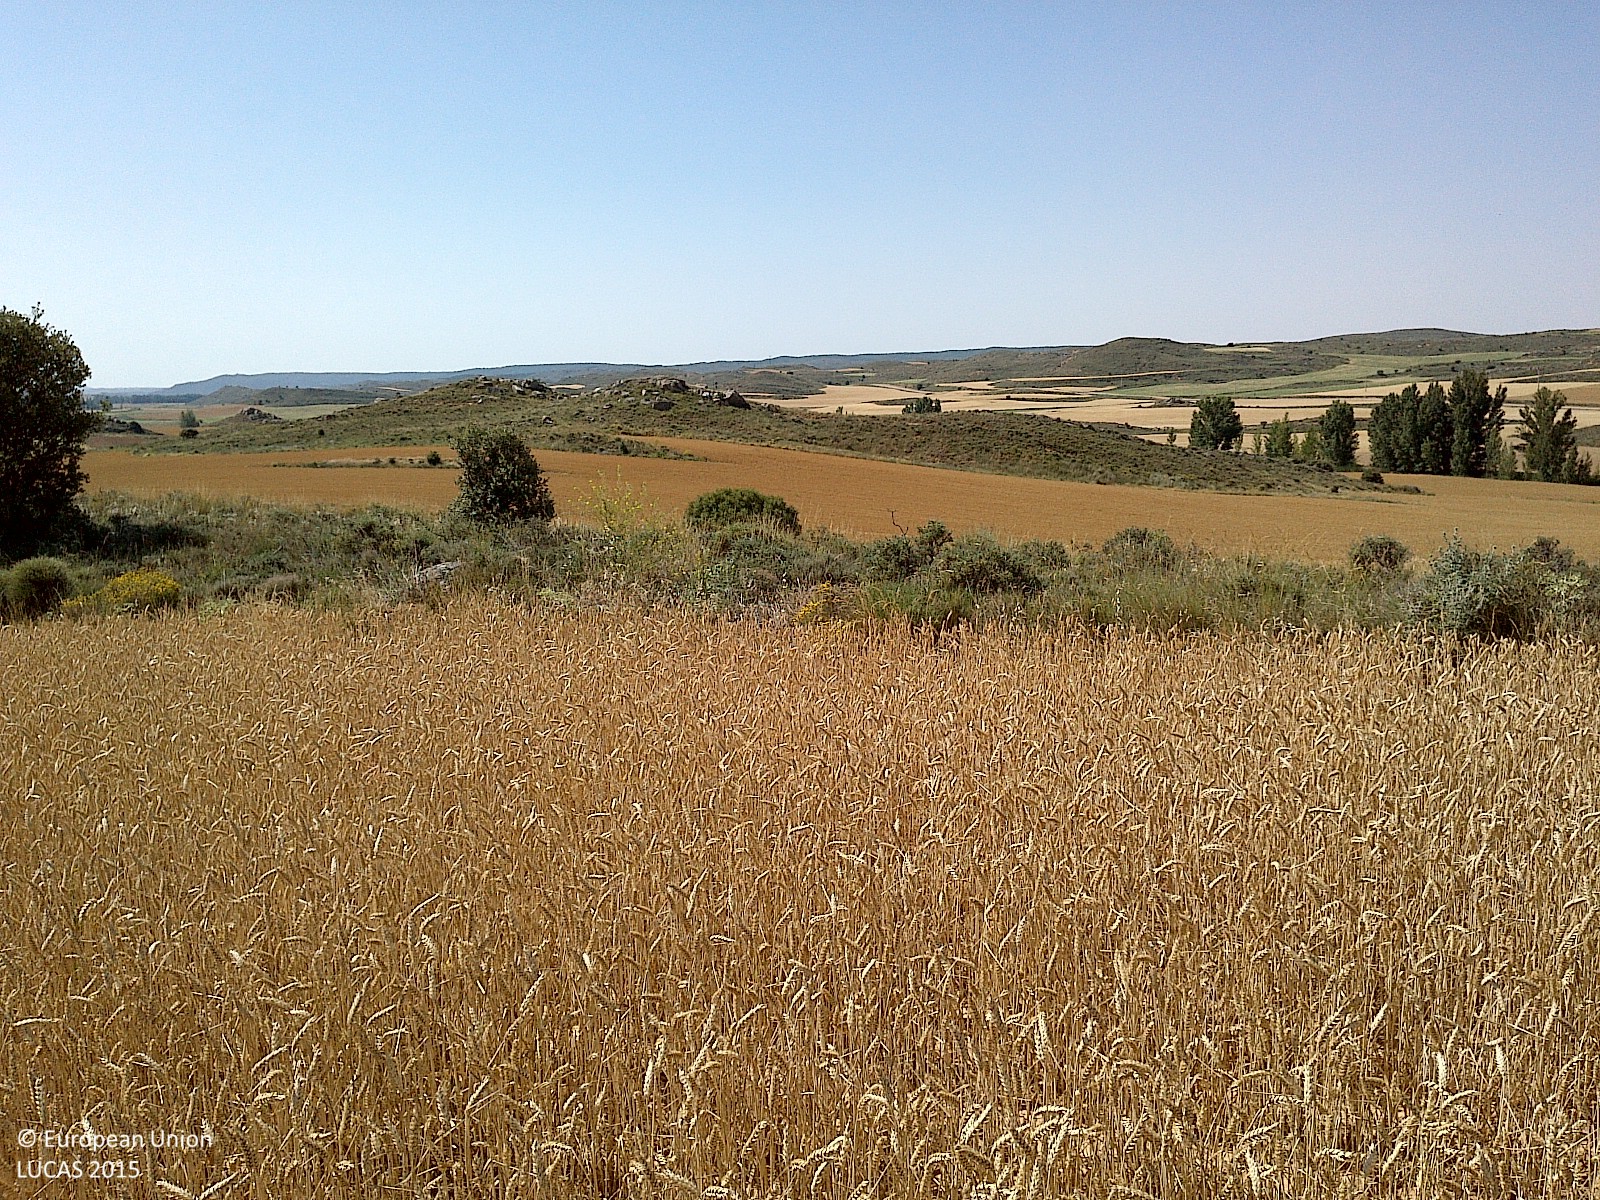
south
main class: Cropland
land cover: Common wheat
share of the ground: > 75 %
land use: Agriculture (excluding fallow land and kitchen gardens)
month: July
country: ES
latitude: 41.5572
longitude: -2.1301
